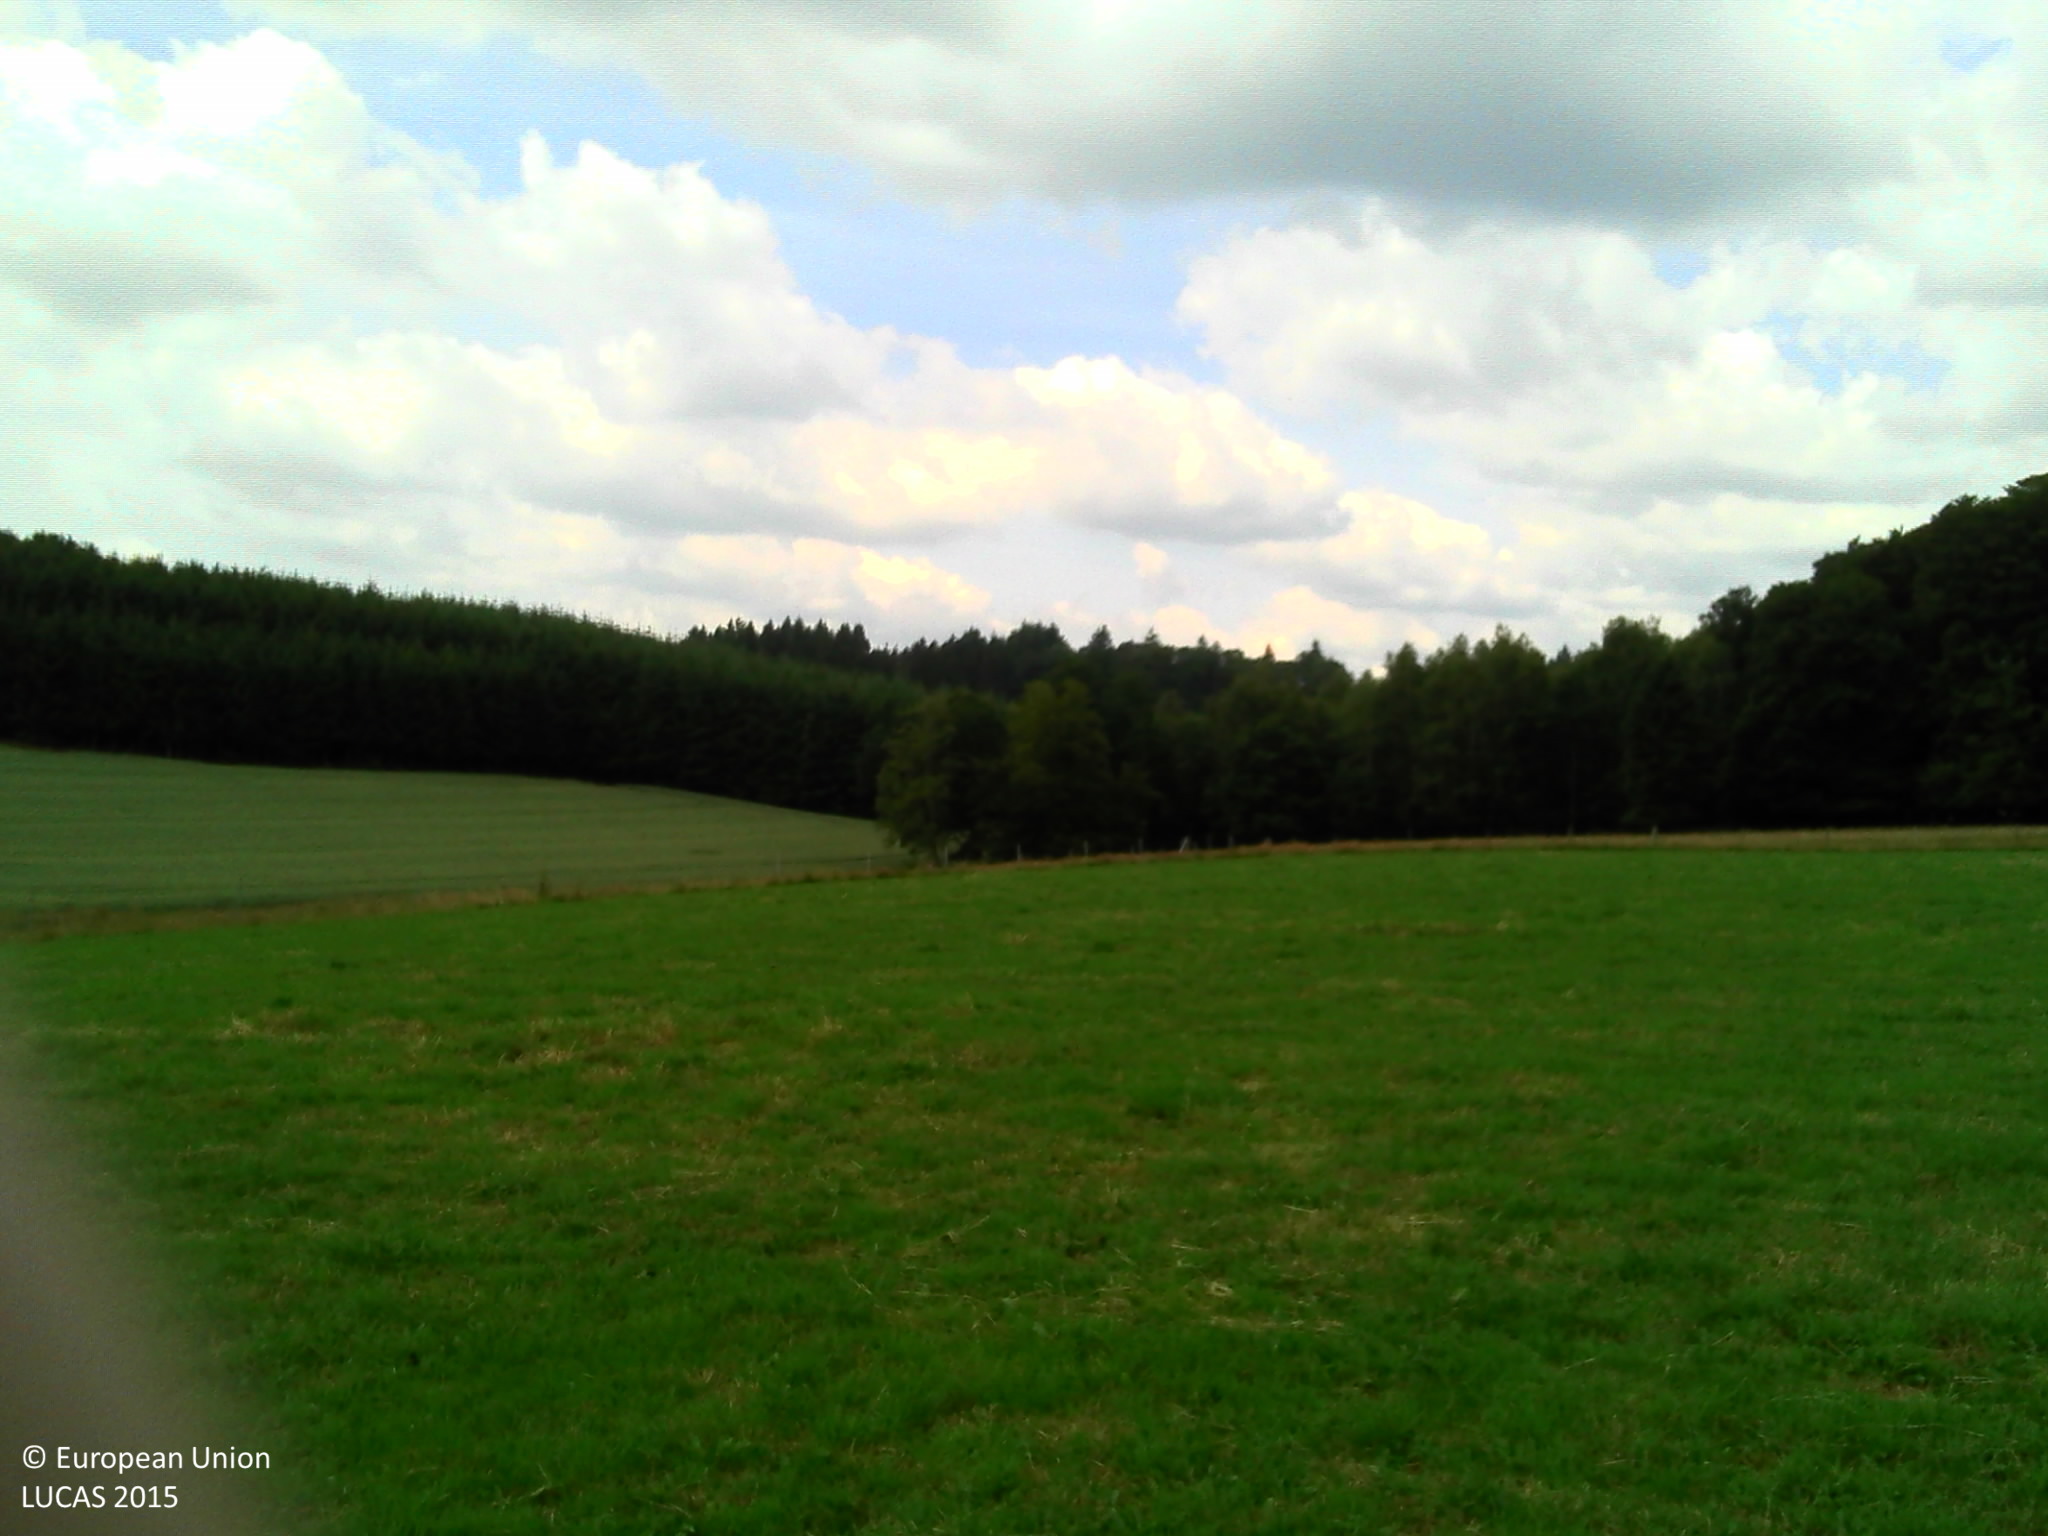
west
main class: Grassland
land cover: Grassland without tree/shrub cover
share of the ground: > 75 %
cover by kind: herbaceous plants 100 %
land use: Agriculture (excluding fallow land and kitchen gardens)
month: June
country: LU
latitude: 49.8443
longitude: 6.0081
